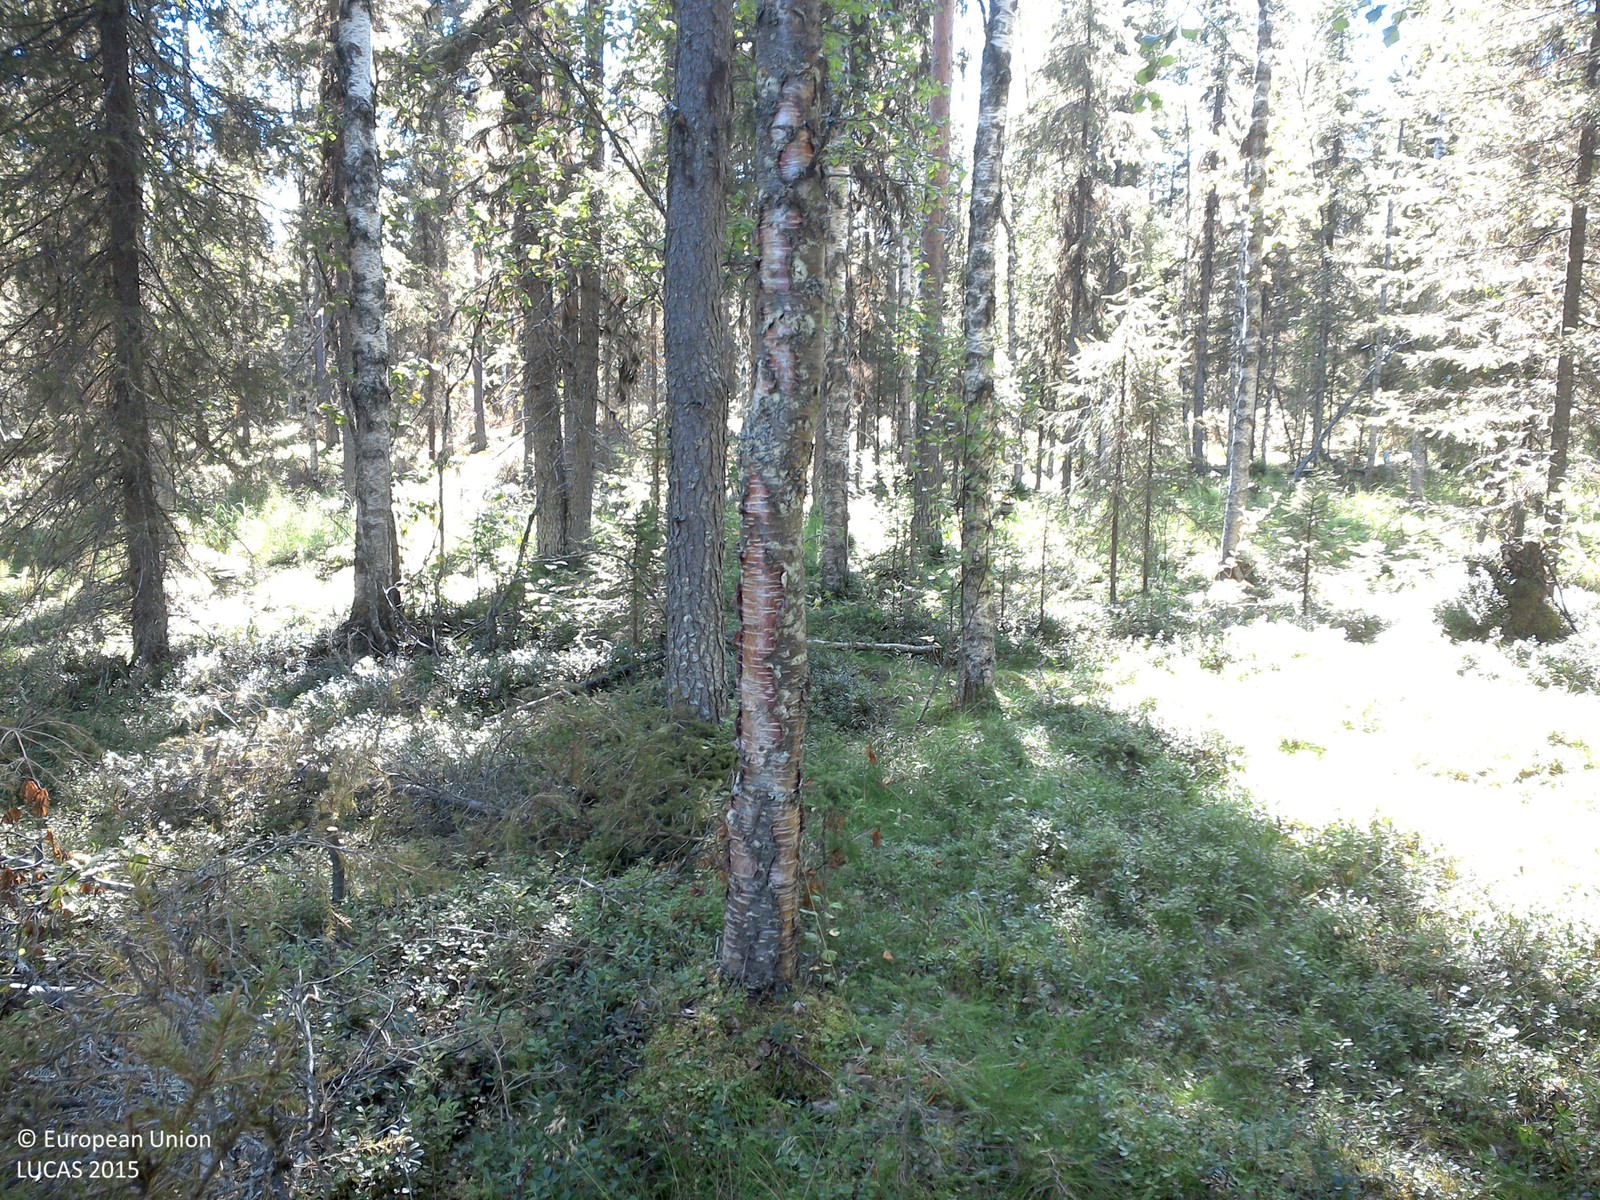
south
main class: Woodland
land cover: Spruce dominated mixed woodland
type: boreal forest
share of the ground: 25 - 50 %
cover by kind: shrubs 60 %, coniferous forest trees 20 %, broadleaved forest trees 15 %, lichens and mosses 5 %
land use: Forestry
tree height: > 5 m
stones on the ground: > 50 %
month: August
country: SE
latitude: 67.1349
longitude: 21.4159
